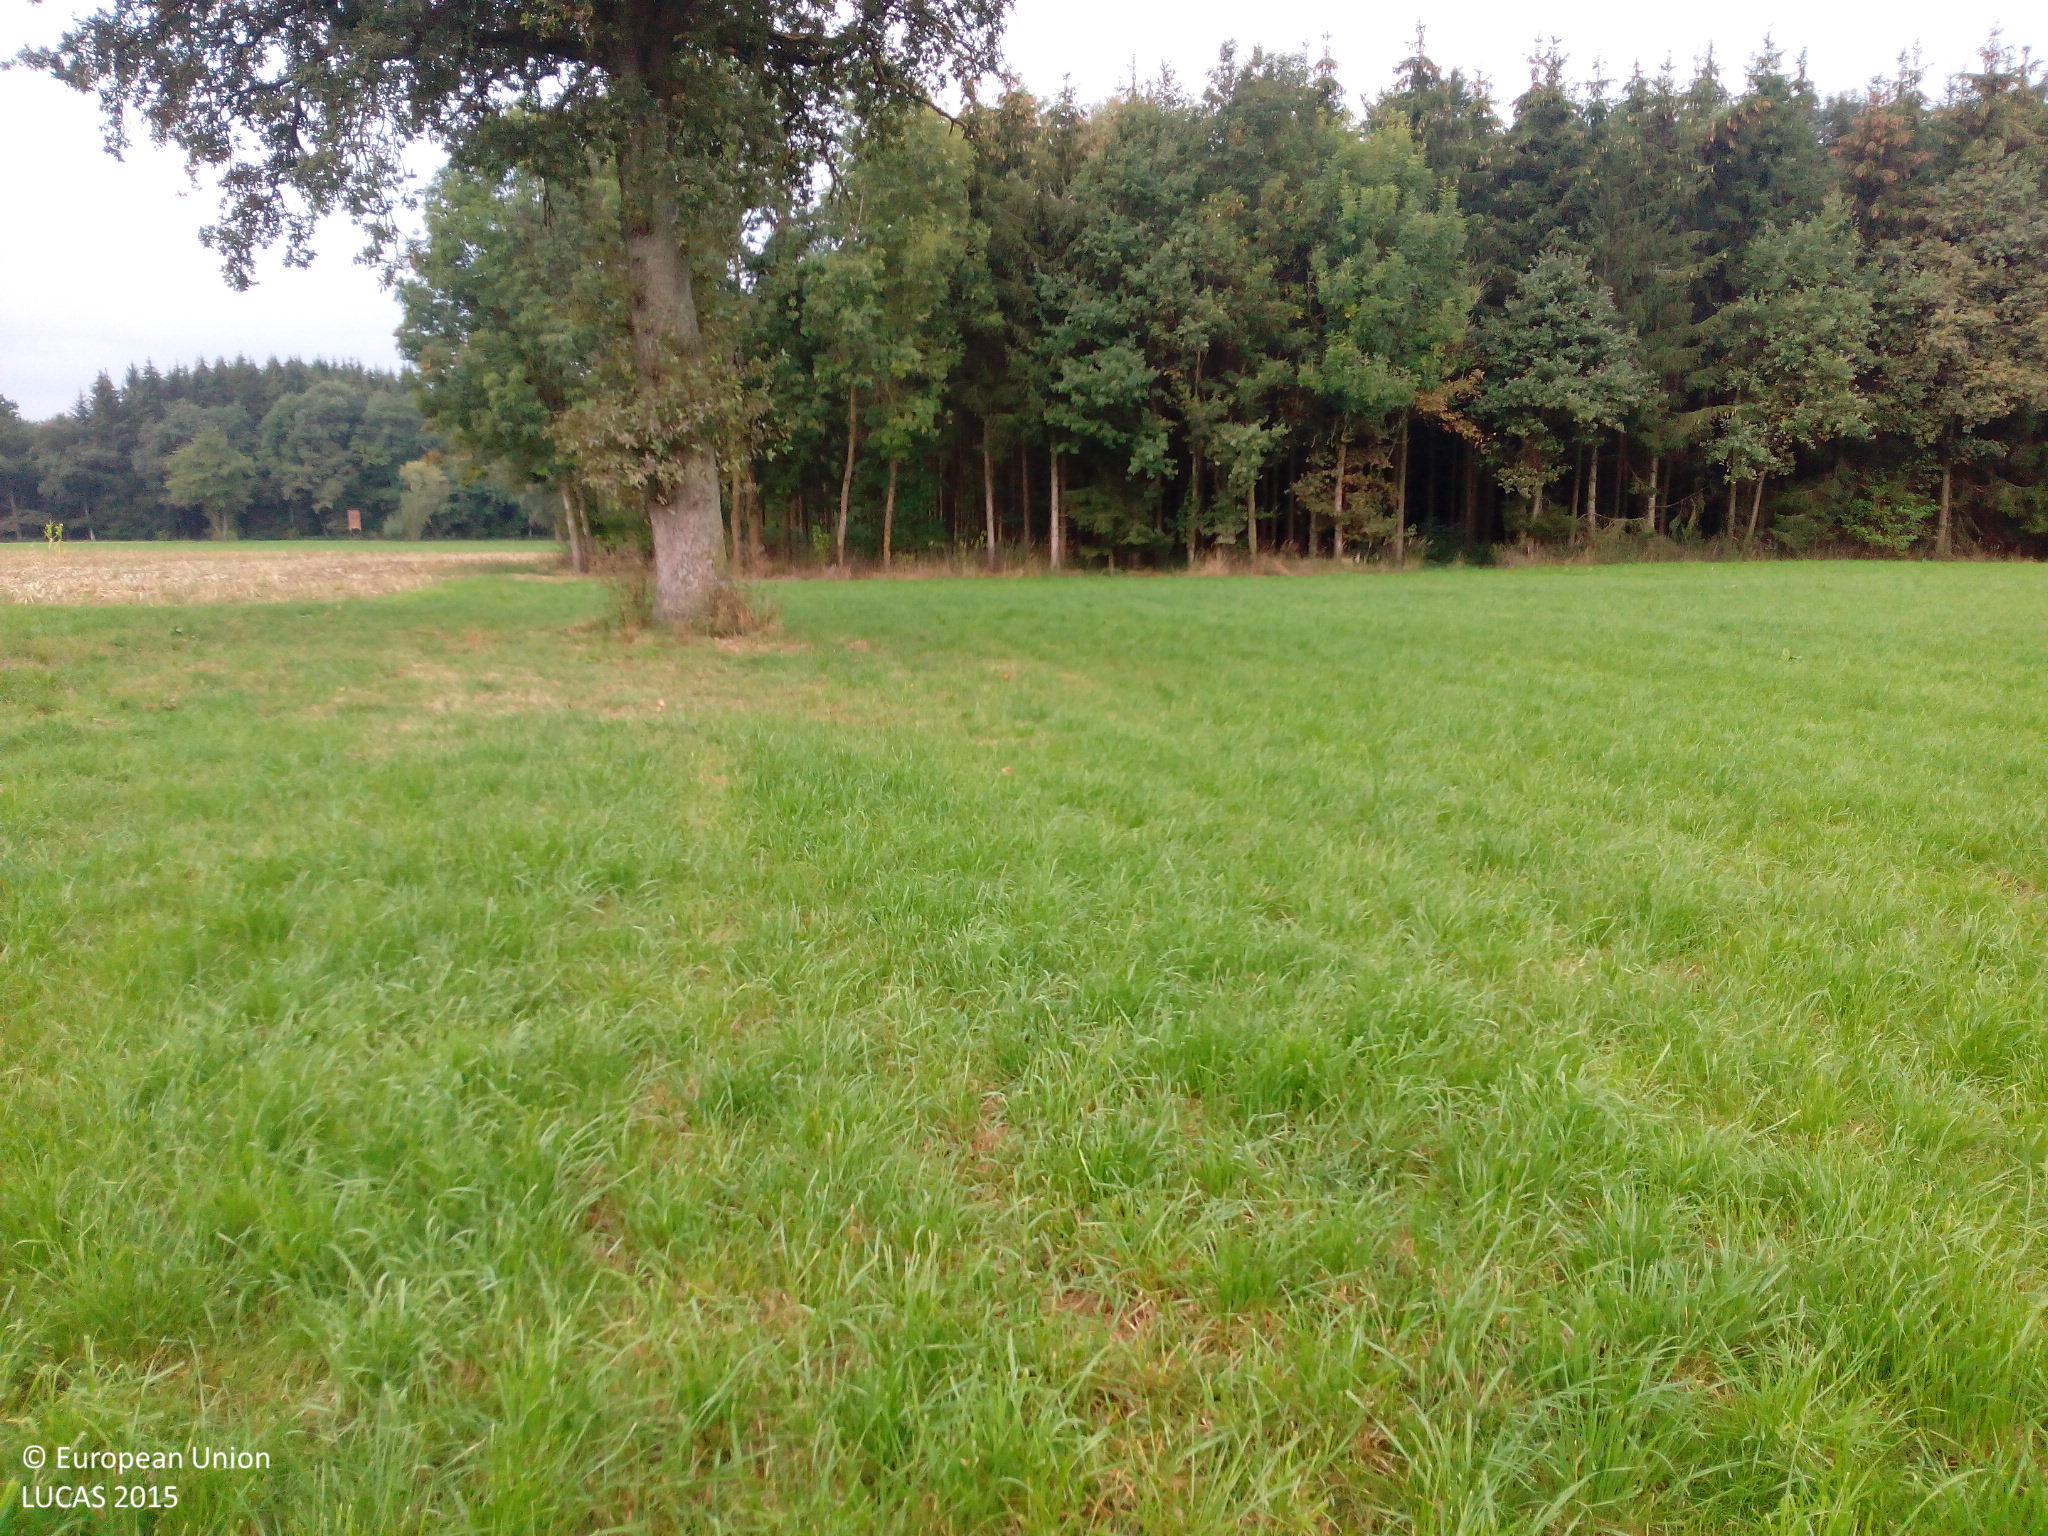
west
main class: Grassland
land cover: Grassland without tree/shrub cover
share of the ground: > 75 %
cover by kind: herbaceous plants 95 %, unconsolidated bare surface 5 %
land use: Agriculture (excluding fallow land and kitchen gardens)
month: September
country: DE
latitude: 48.3757
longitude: 11.4708
